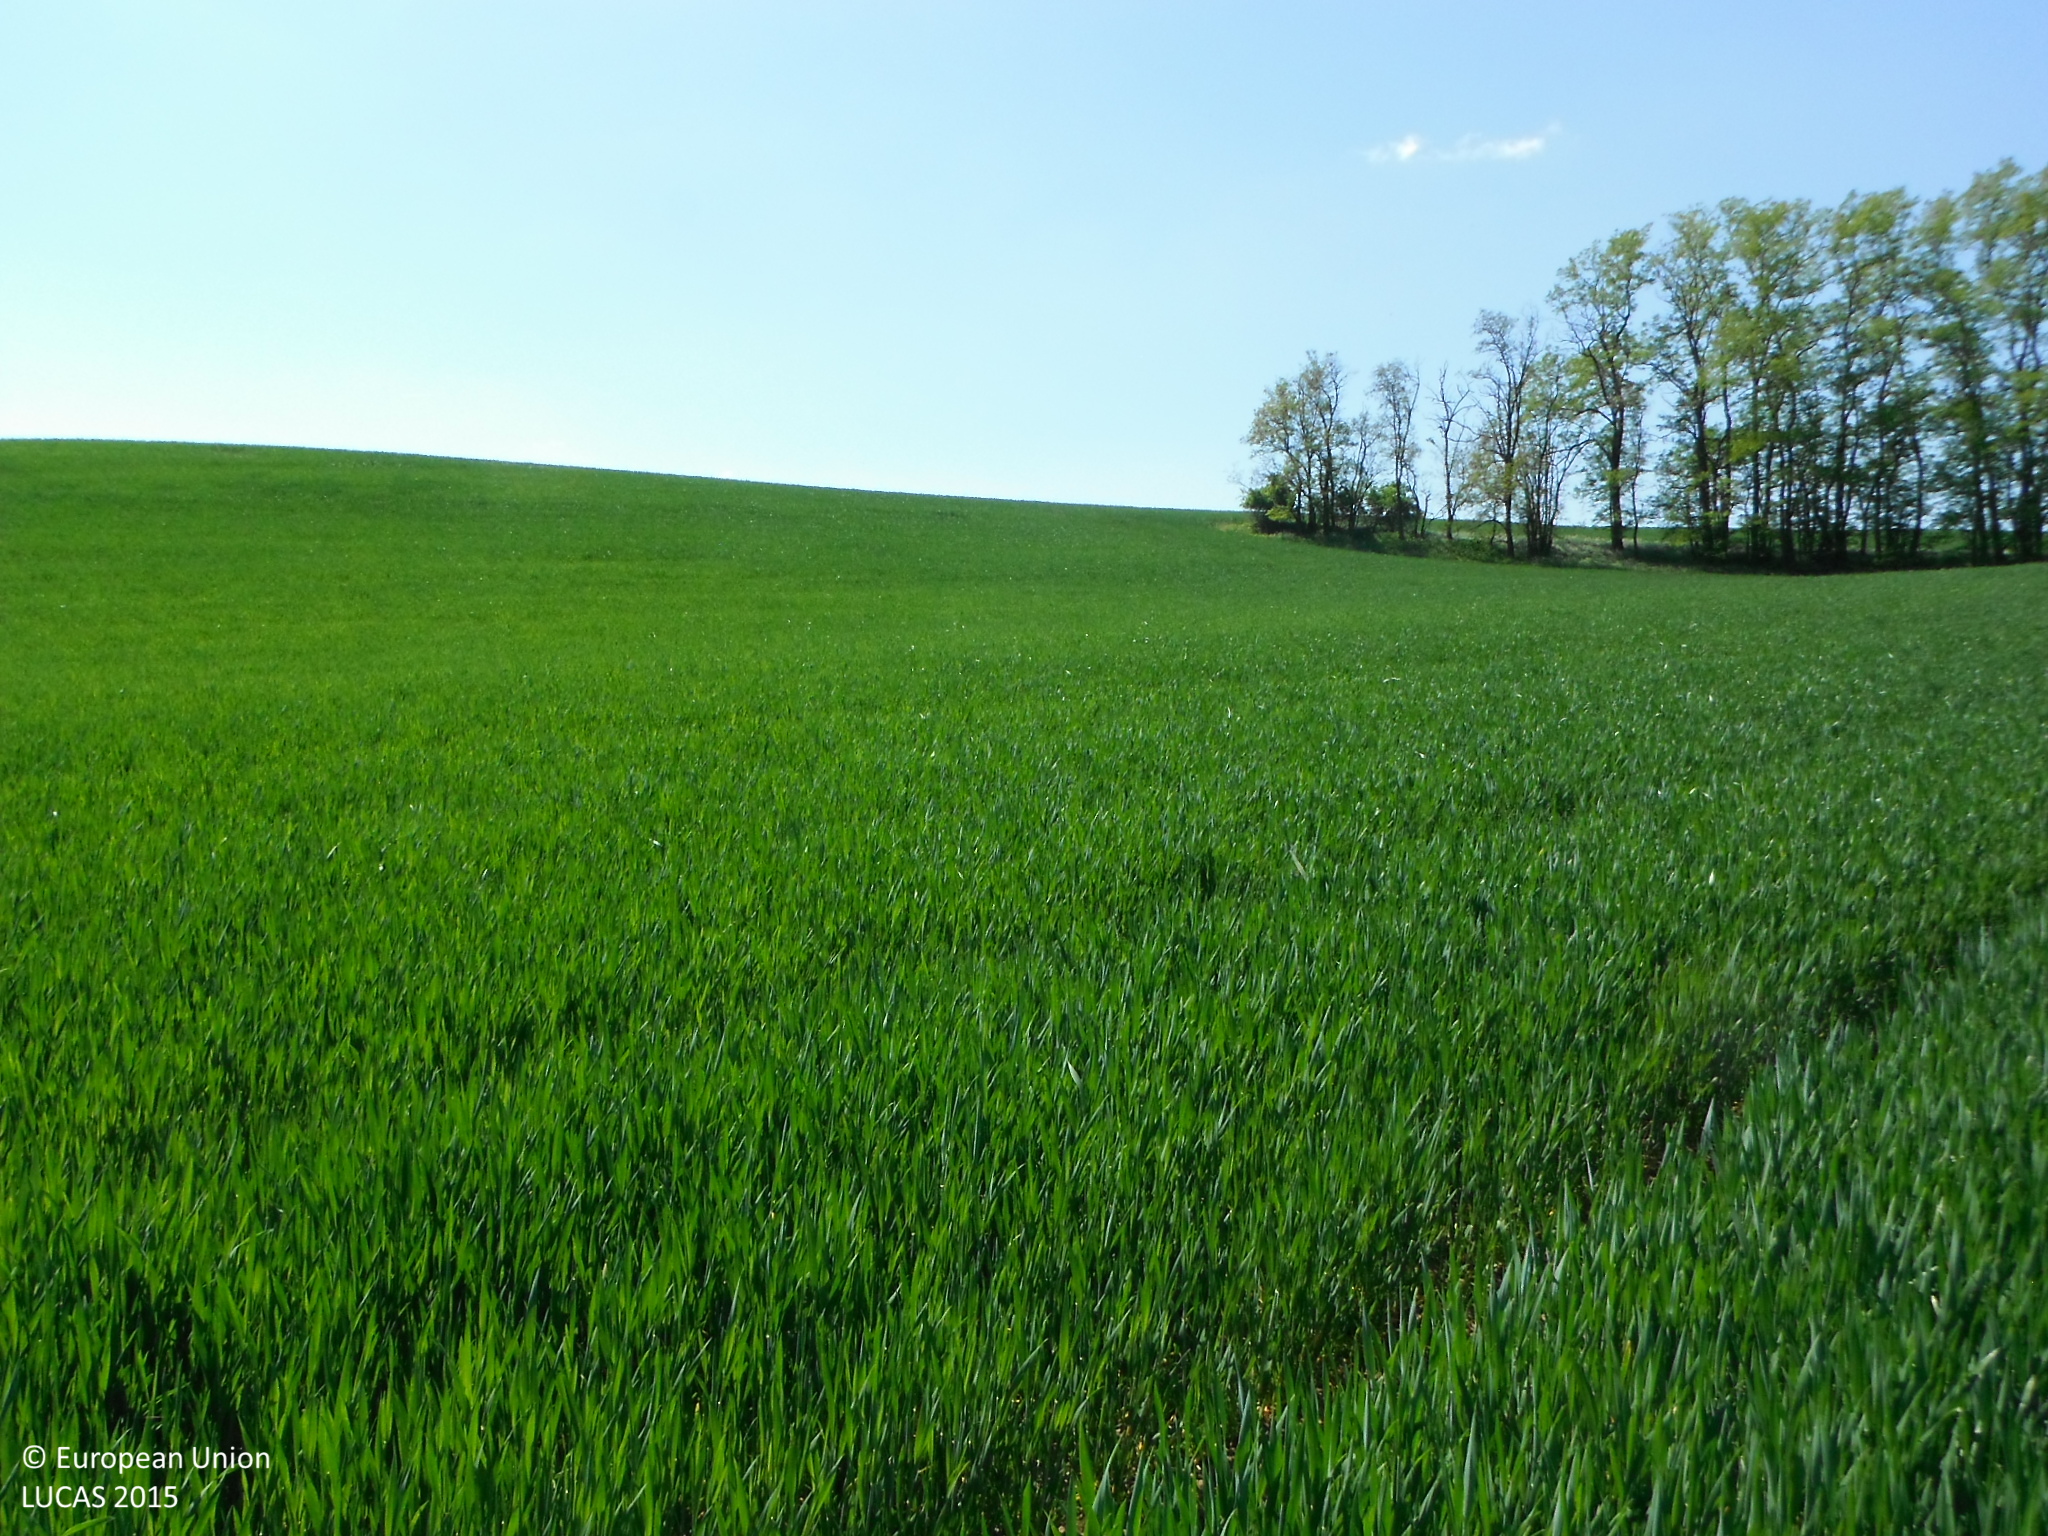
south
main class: Cropland
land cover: Common wheat
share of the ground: > 75 %
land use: Agriculture (excluding fallow land and kitchen gardens)
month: May
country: SK
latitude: 48.3136
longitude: 18.2265
